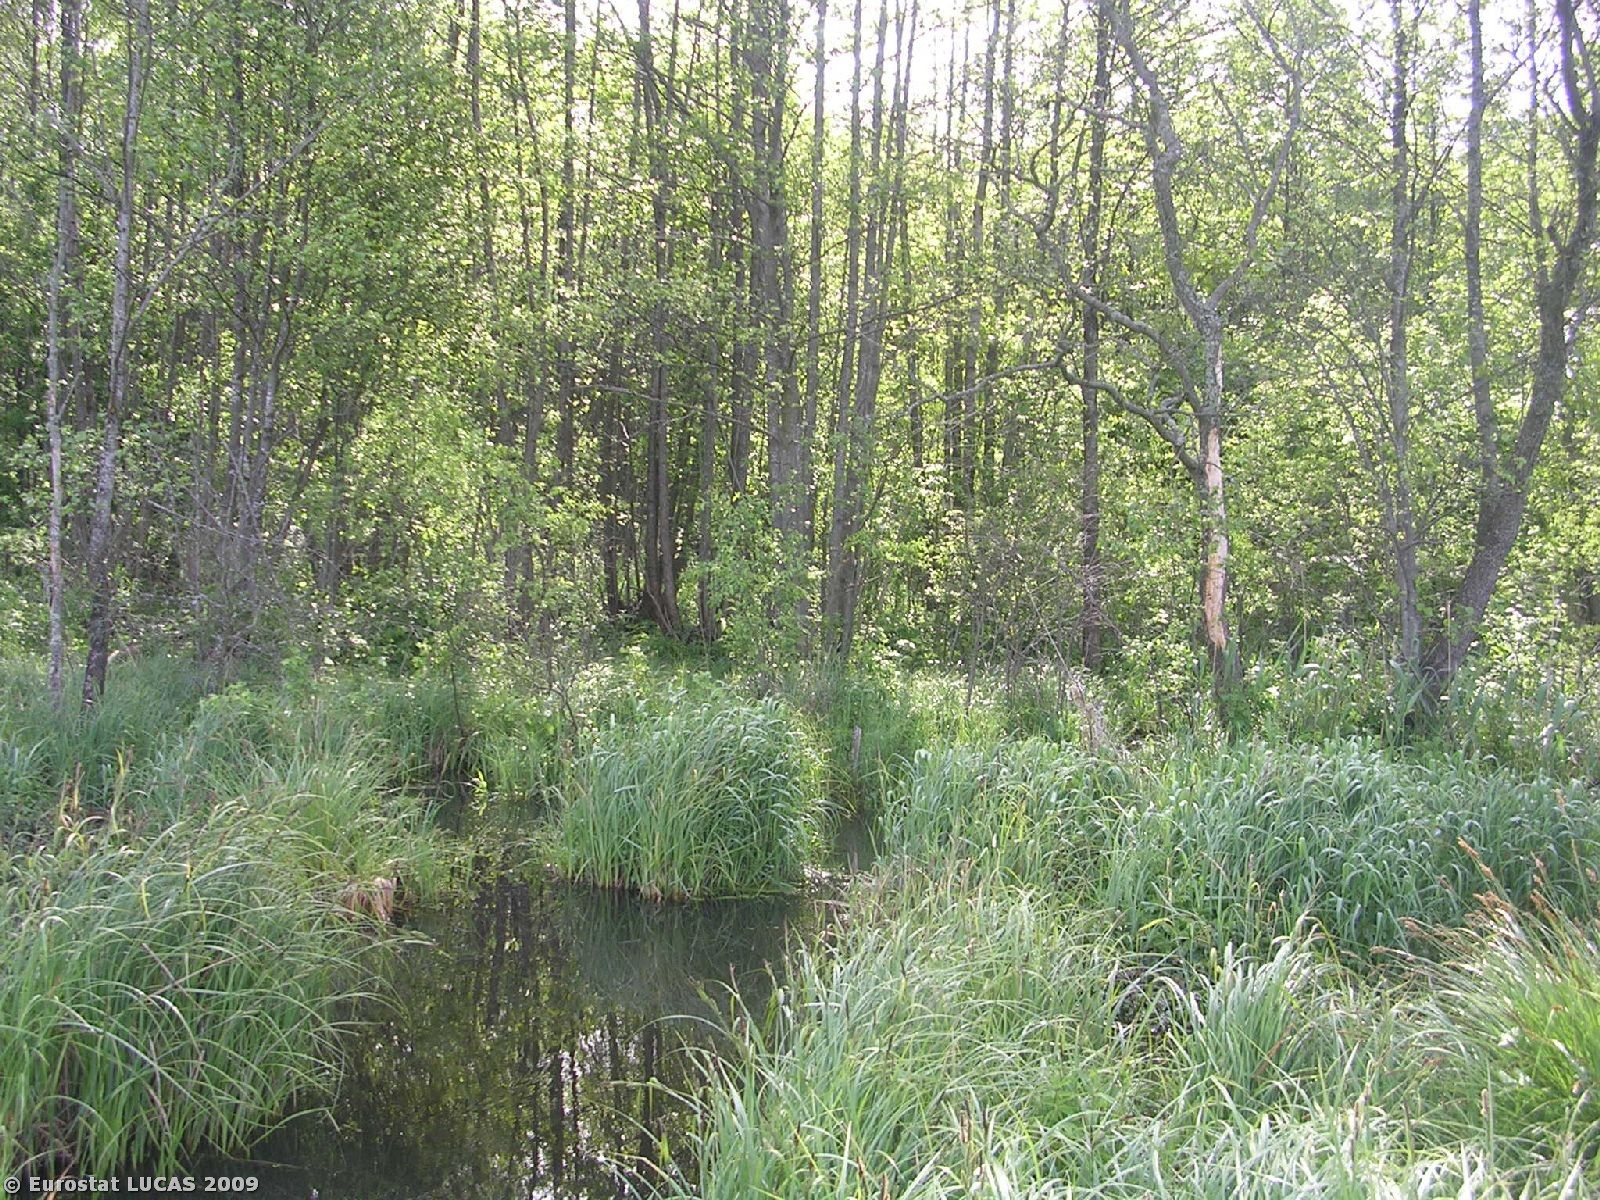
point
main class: Wetlands
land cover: Inland marshes
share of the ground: > 75 %
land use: Unused
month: May
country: PL
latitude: 53.2702
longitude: 23.2594
